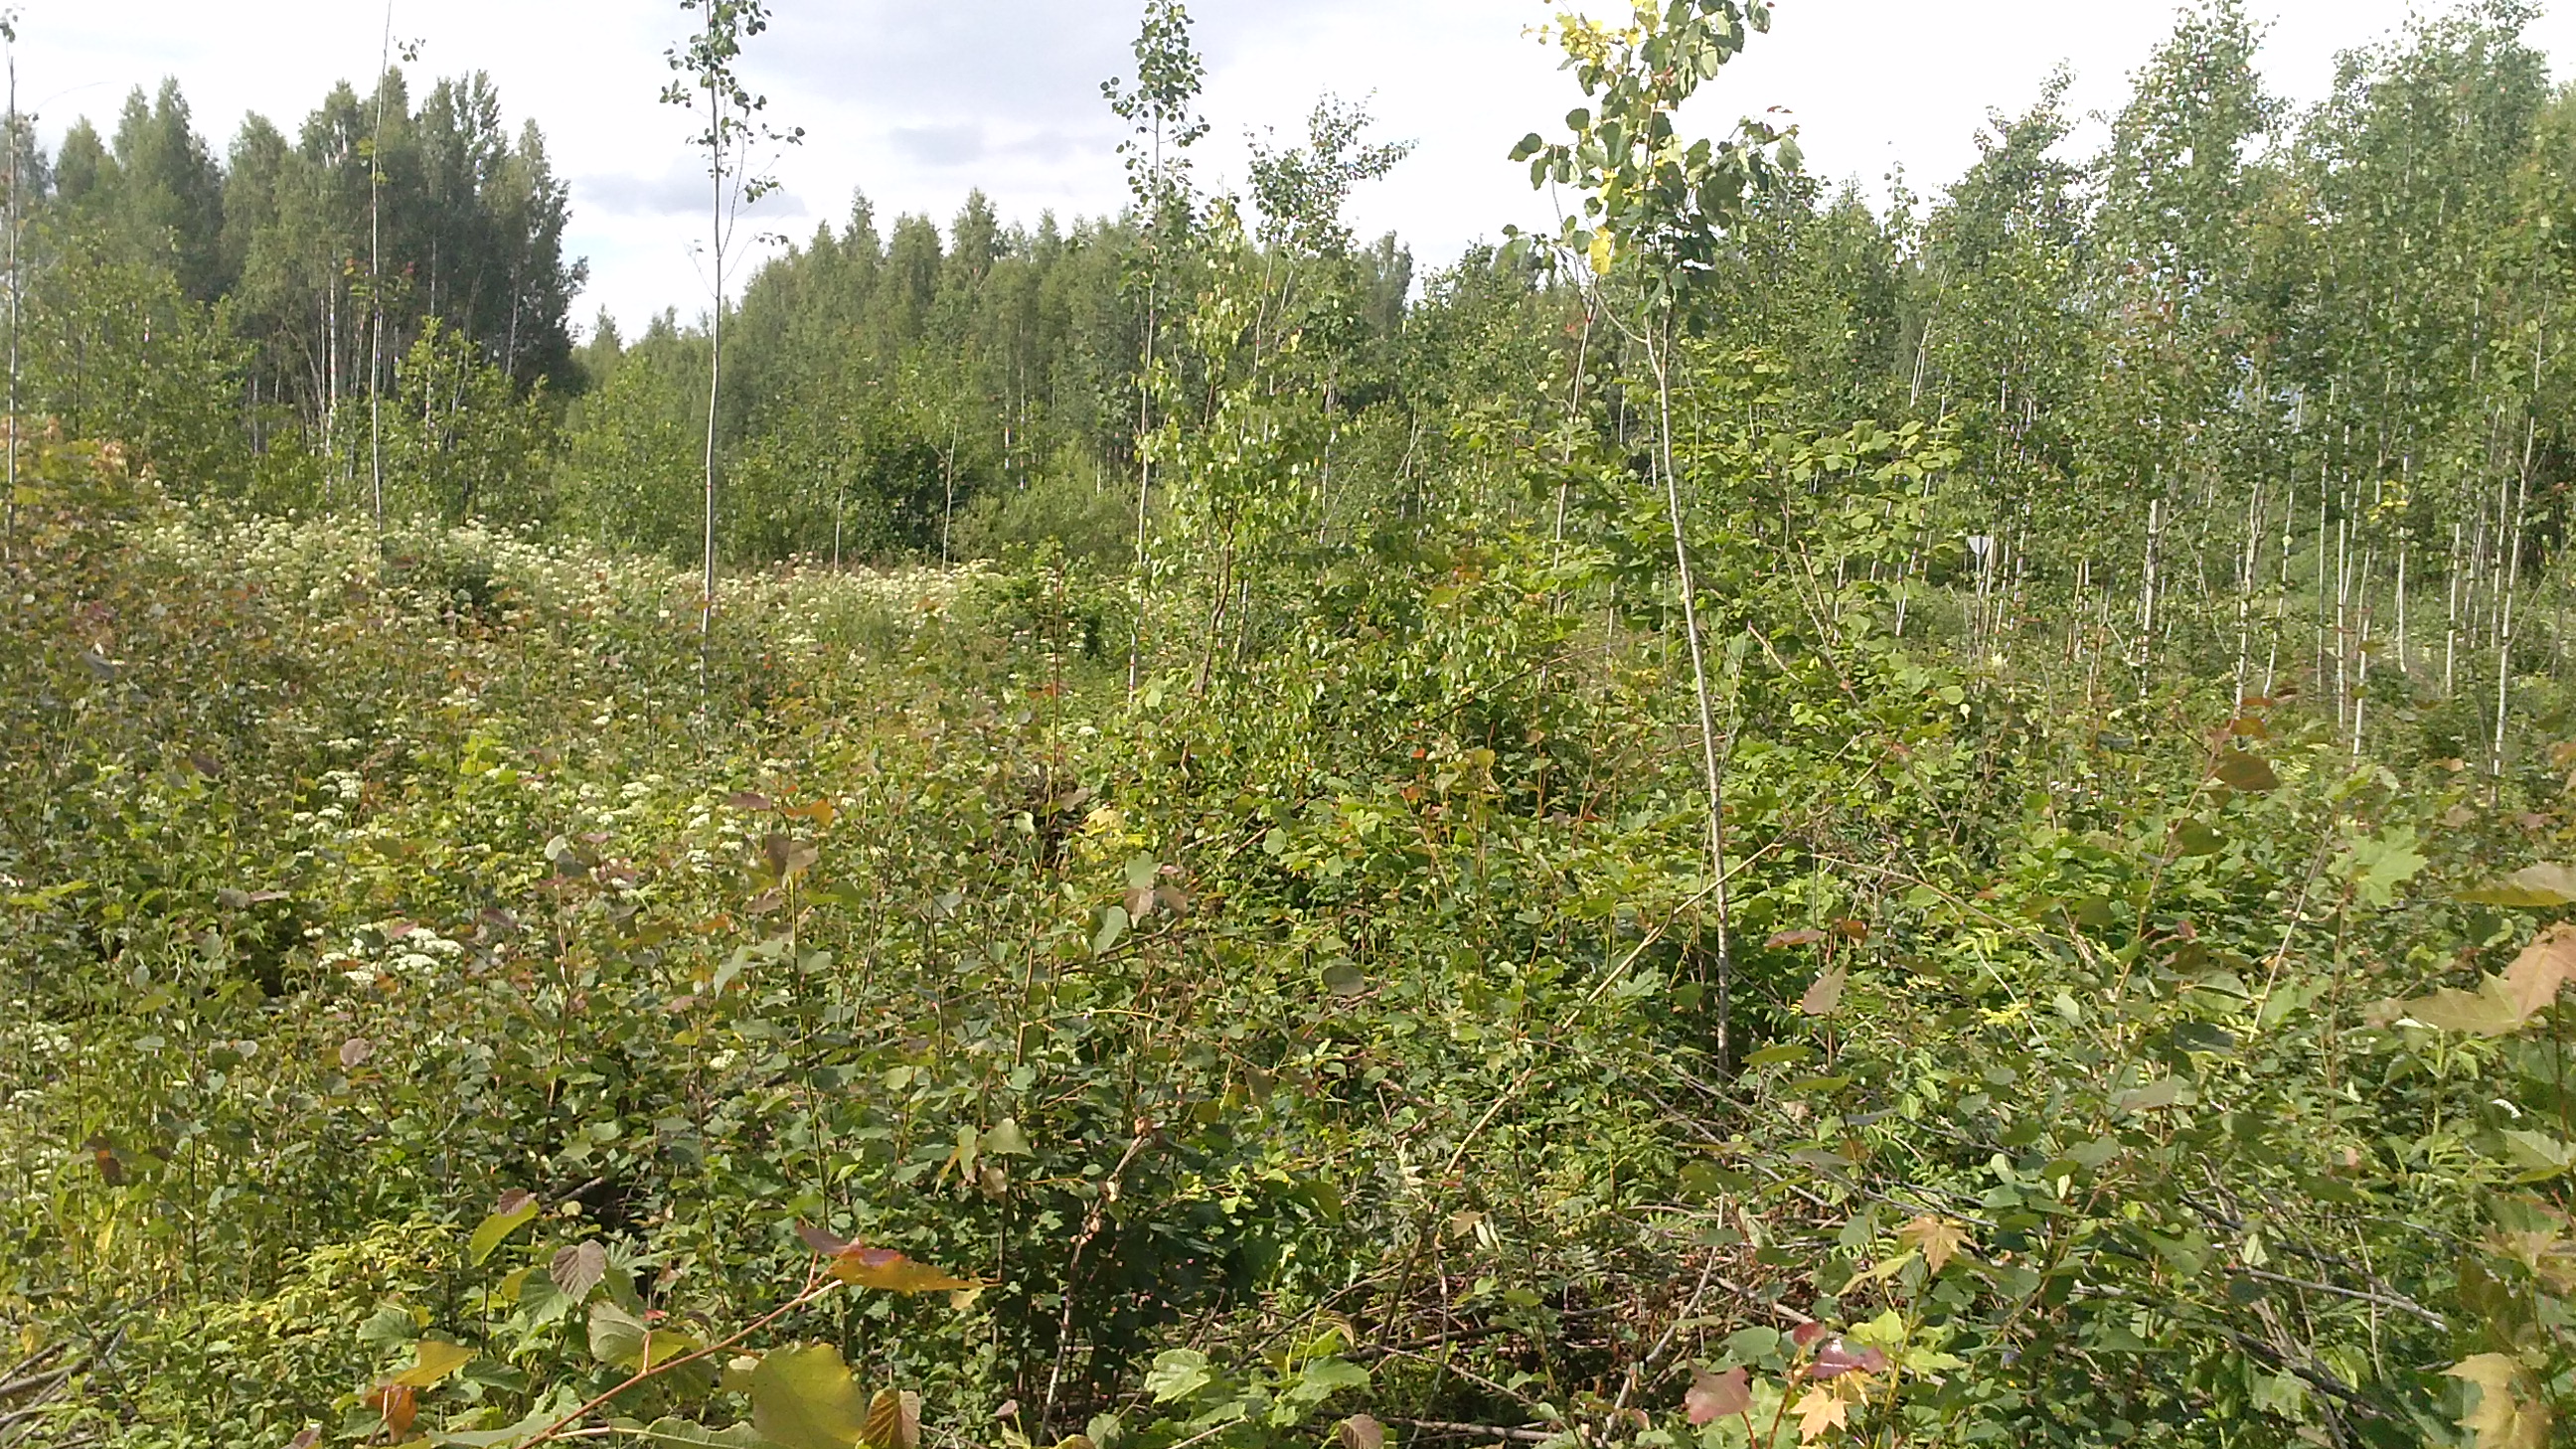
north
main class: Woodland
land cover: Broadleaved woodland
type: non-riverine alder, birch or aspen forest
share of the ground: > 75 %
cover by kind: broadleaved forest trees 100 %
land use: Forestry
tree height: < 5 m
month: June
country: LV
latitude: 56.6602
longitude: 27.9605
